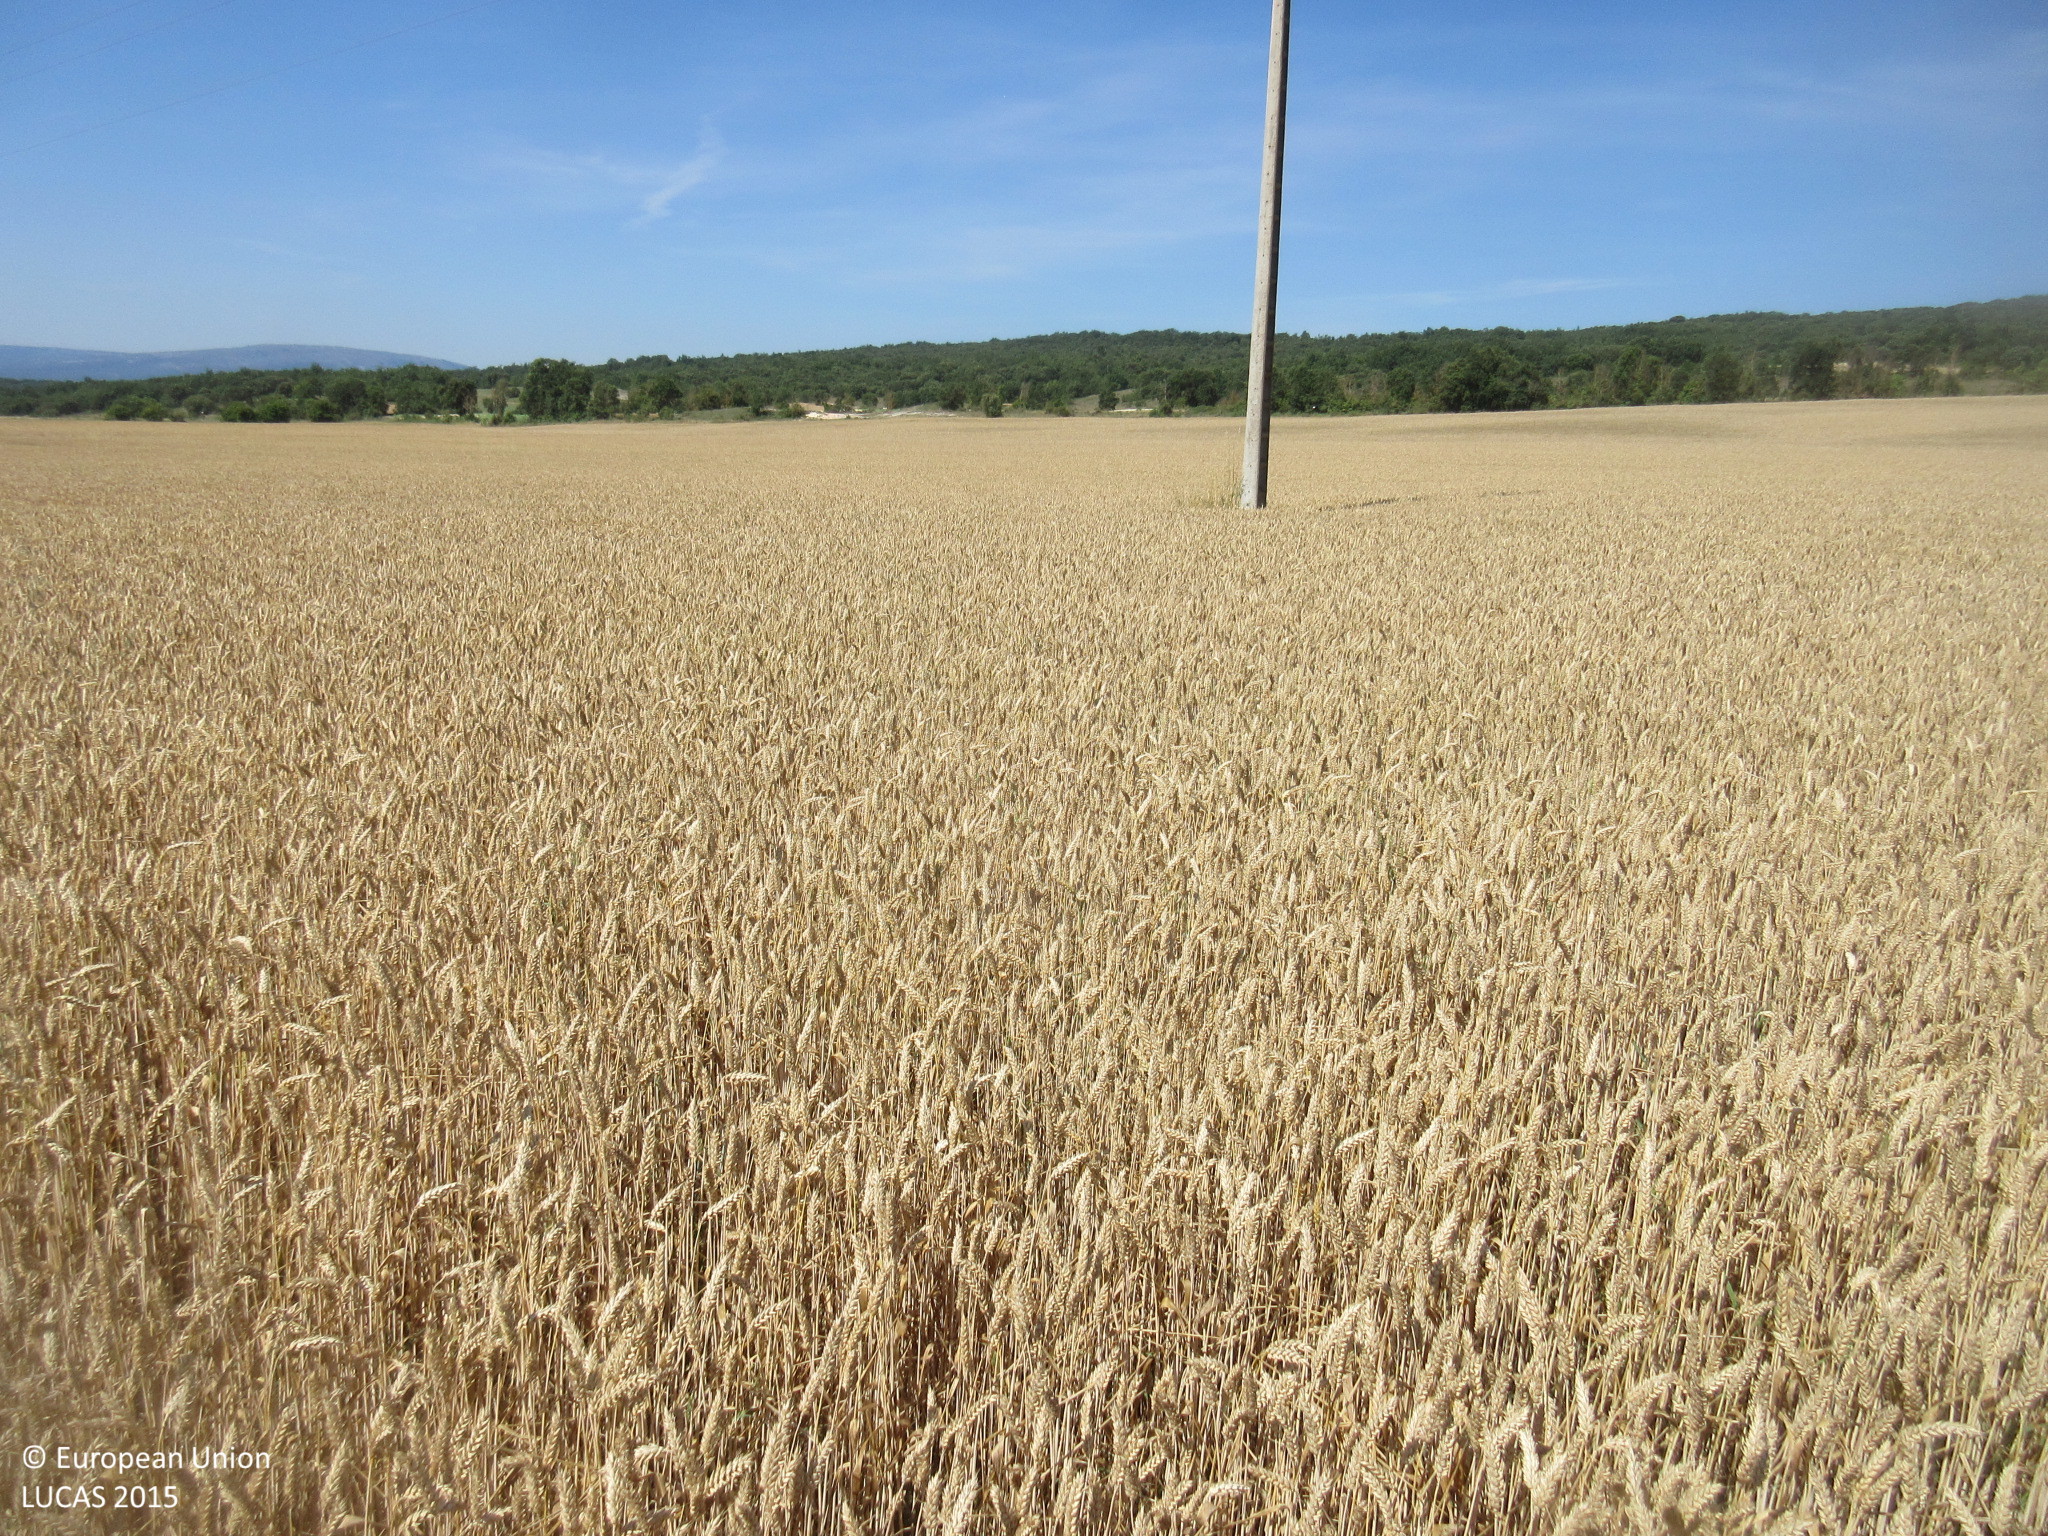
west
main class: Cropland
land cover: Common wheat
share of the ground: > 75 %
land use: Agriculture (excluding fallow land and kitchen gardens)
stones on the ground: < 10 %
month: July
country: ES
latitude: 42.9685
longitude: -3.5141
